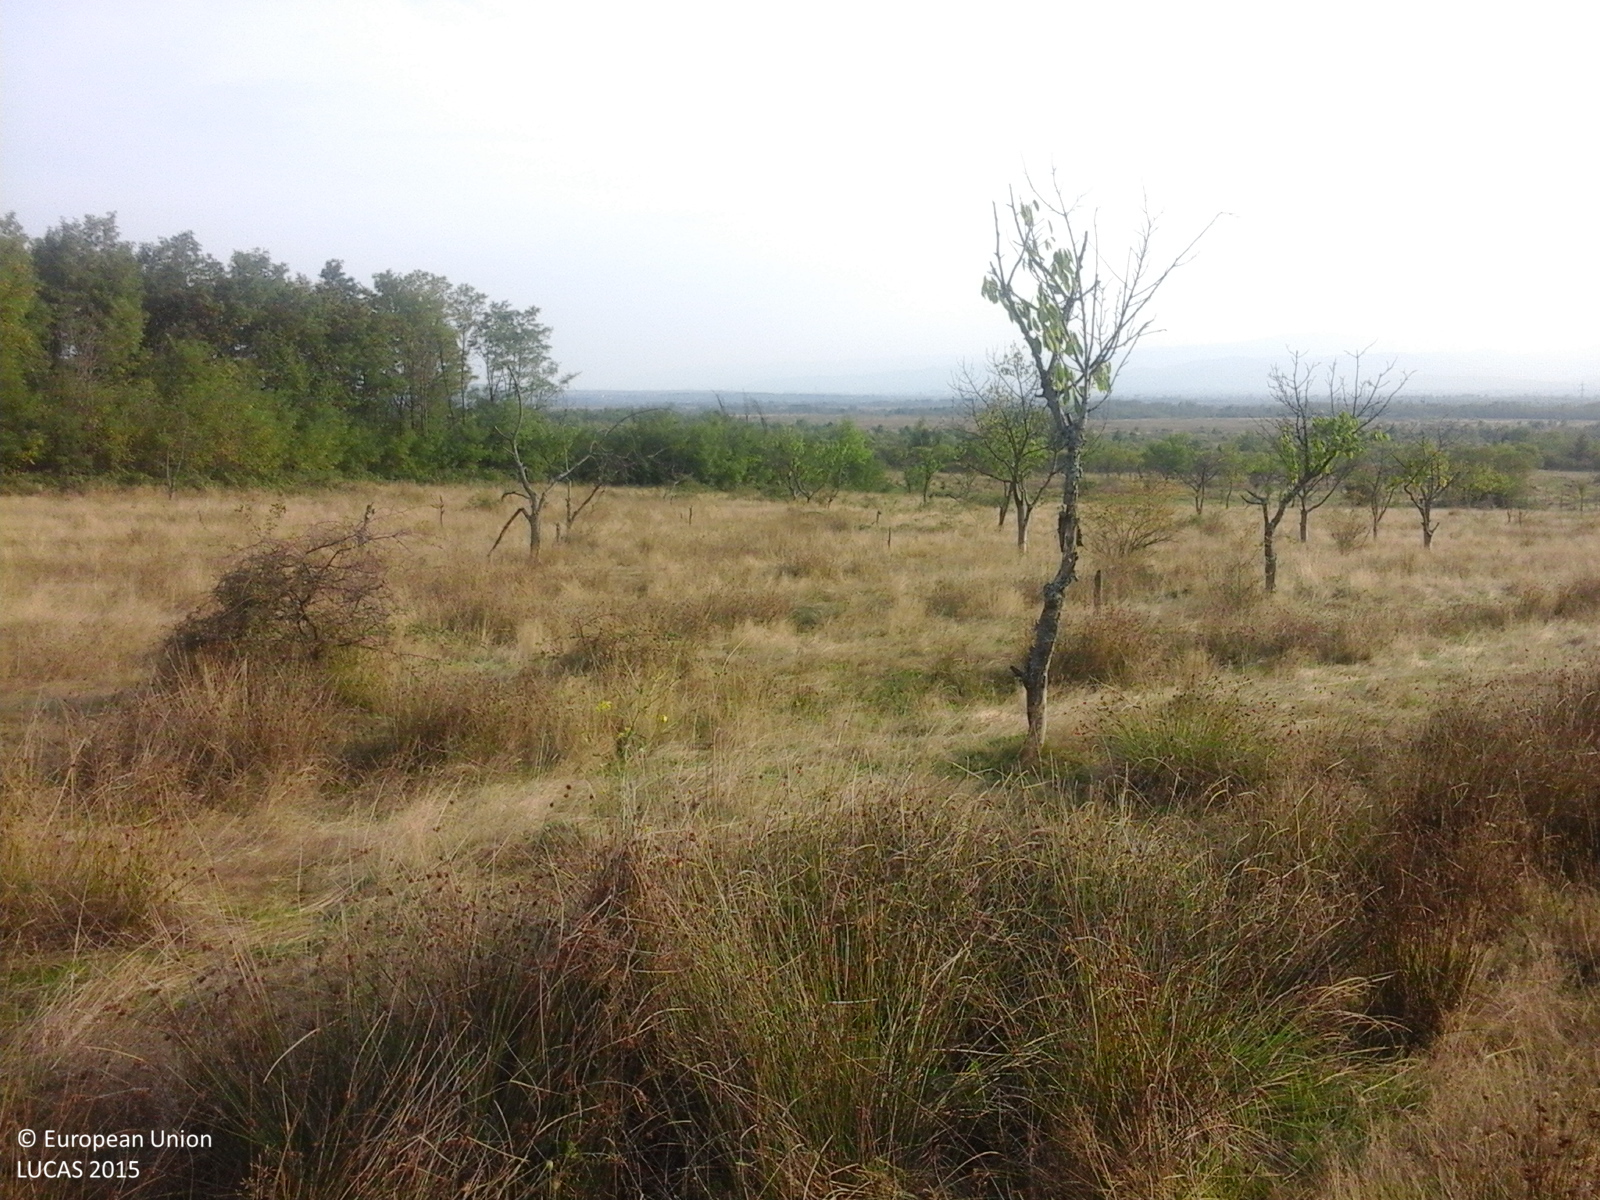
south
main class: Cropland
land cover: Cherry fruit
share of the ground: 50 - 75 %
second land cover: Grassland without tree/shrub cover
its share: > 75 %
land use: Agriculture (excluding fallow land and kitchen gardens)
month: September
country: RO
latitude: 45.5205
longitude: 22.2165
